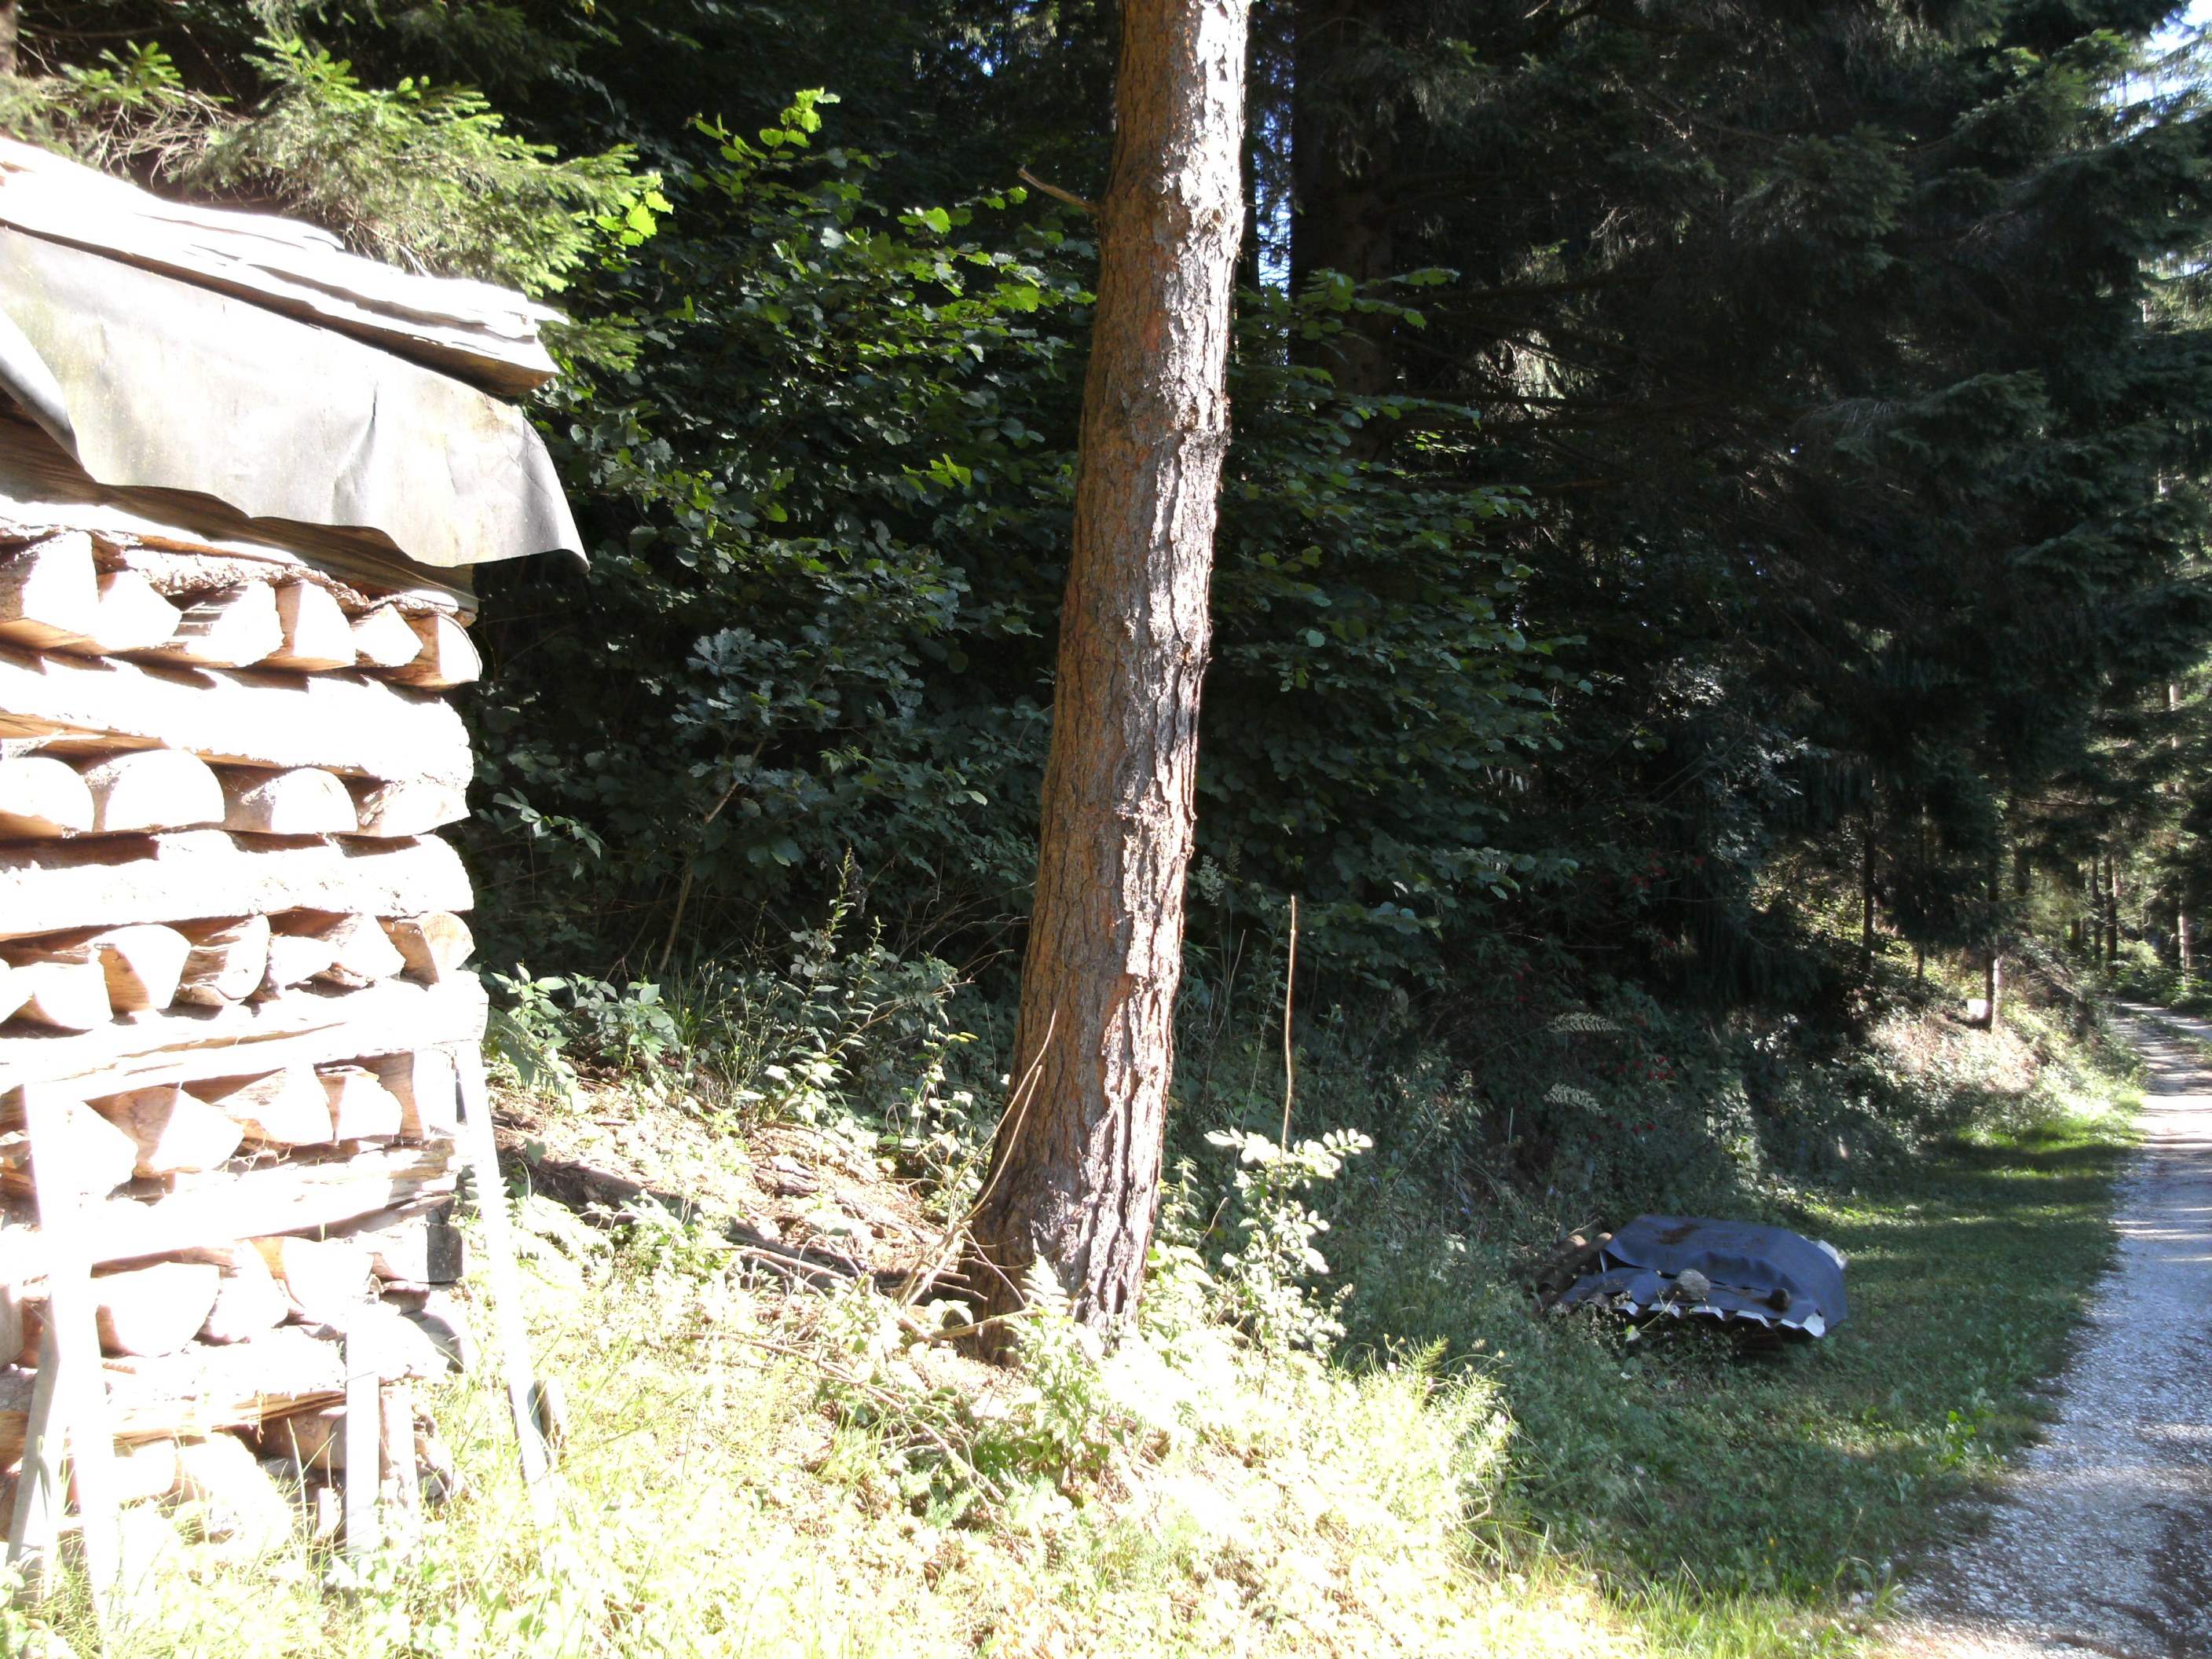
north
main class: Woodland
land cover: Spruce dominated coniferous woodland
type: alpine coniferous forest
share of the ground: > 75 %
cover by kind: coniferous forest trees 80 %, shrubs 10 %, herbaceous plants 5 %, unconsolidated bare surface 5 %
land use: Forestry
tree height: > 5 m
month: July
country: AT
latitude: 46.9090
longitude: 14.8431
